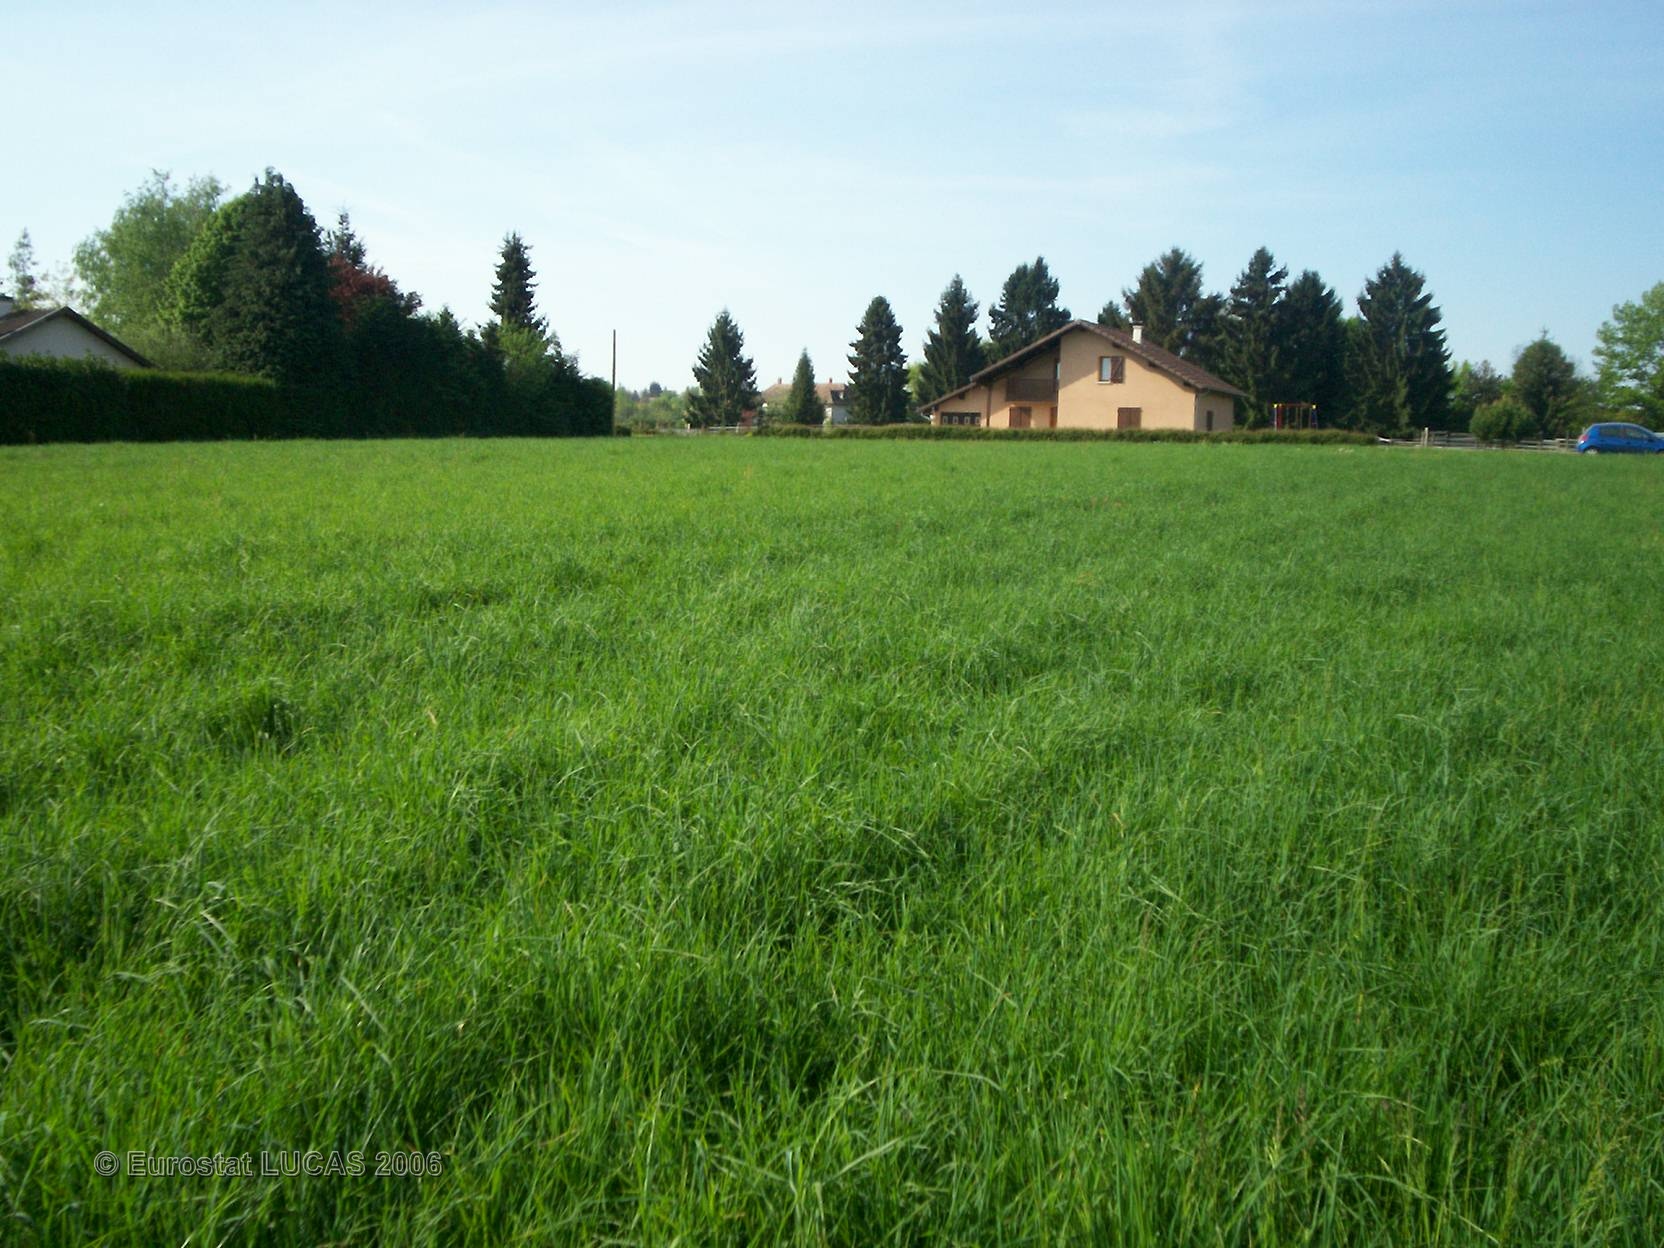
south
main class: Grassland
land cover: Grassland without tree/shrub cover
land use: Agriculture (excluding fallow land and kitchen gardens)
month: May
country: FR
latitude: 45.6241
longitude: 5.4768
